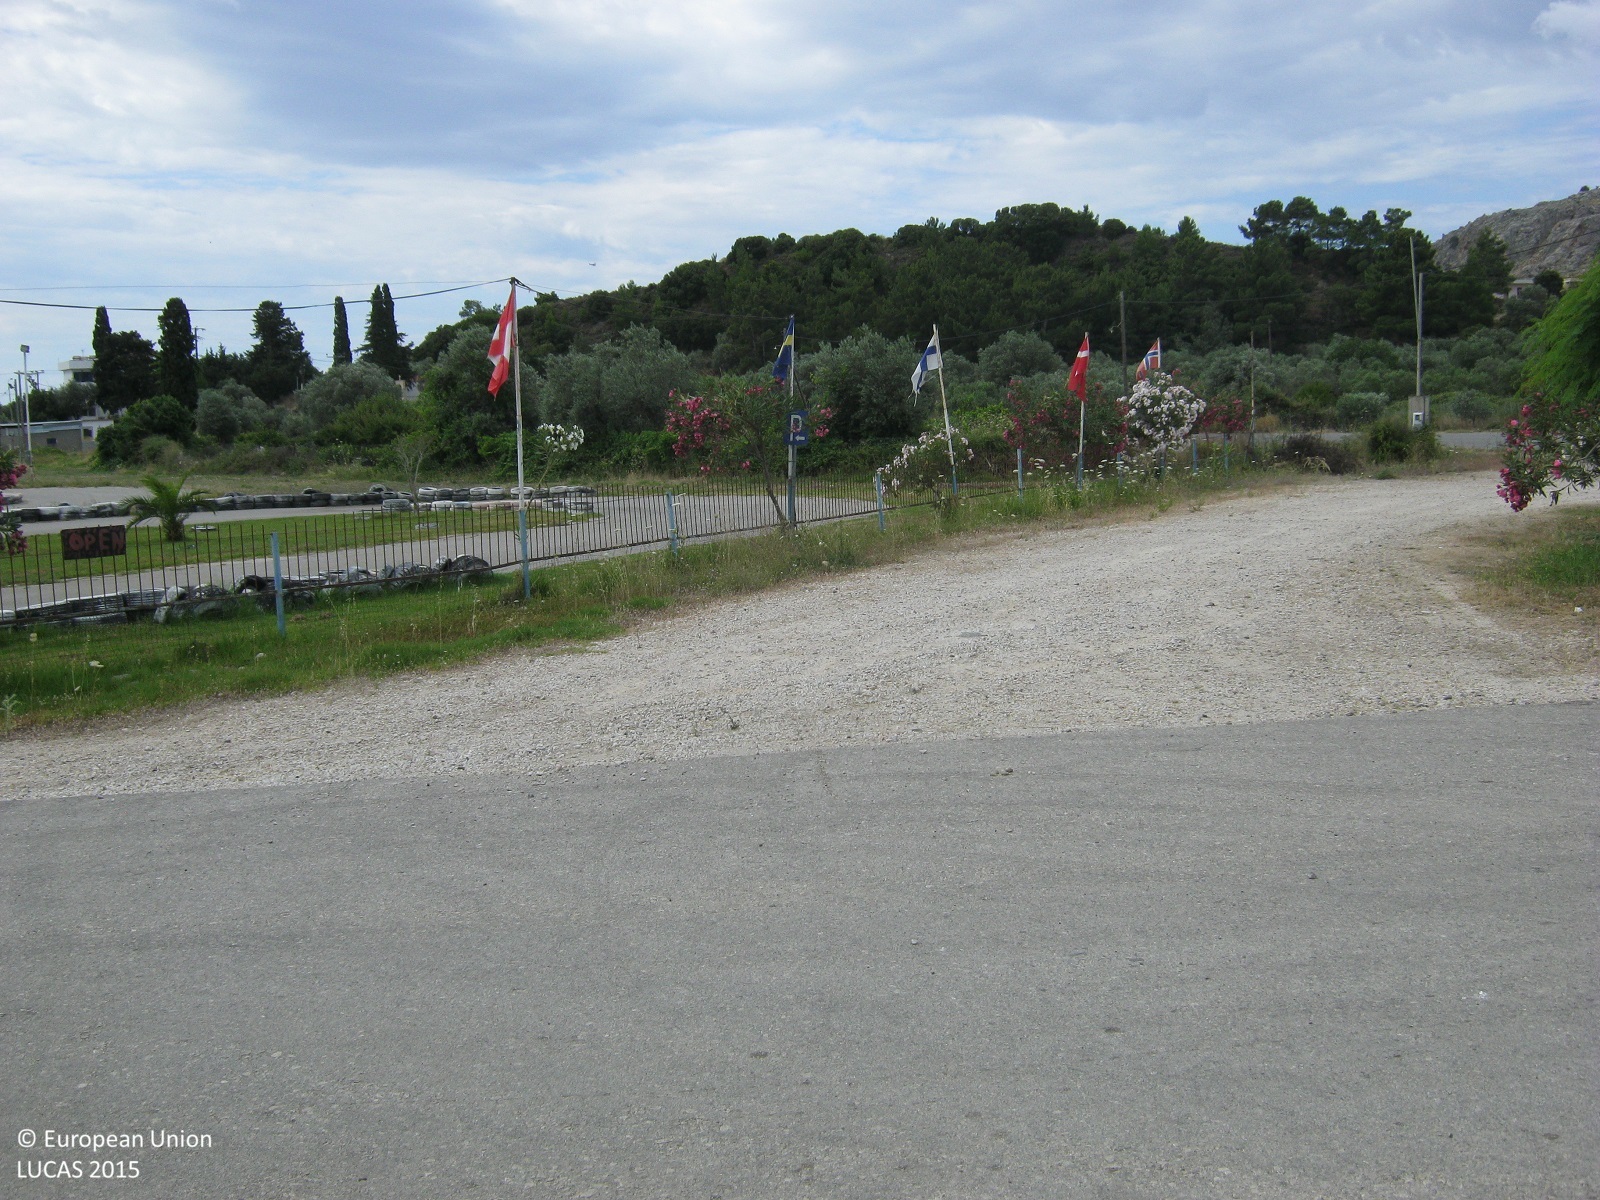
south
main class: Cropland
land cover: Vineyards
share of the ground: 50 - 75 %
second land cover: Spontaneously vegetated surfaces
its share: > 75 %
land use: Agriculture (excluding fallow land and kitchen gardens)
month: June
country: GR
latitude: 36.0861
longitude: 28.0139
